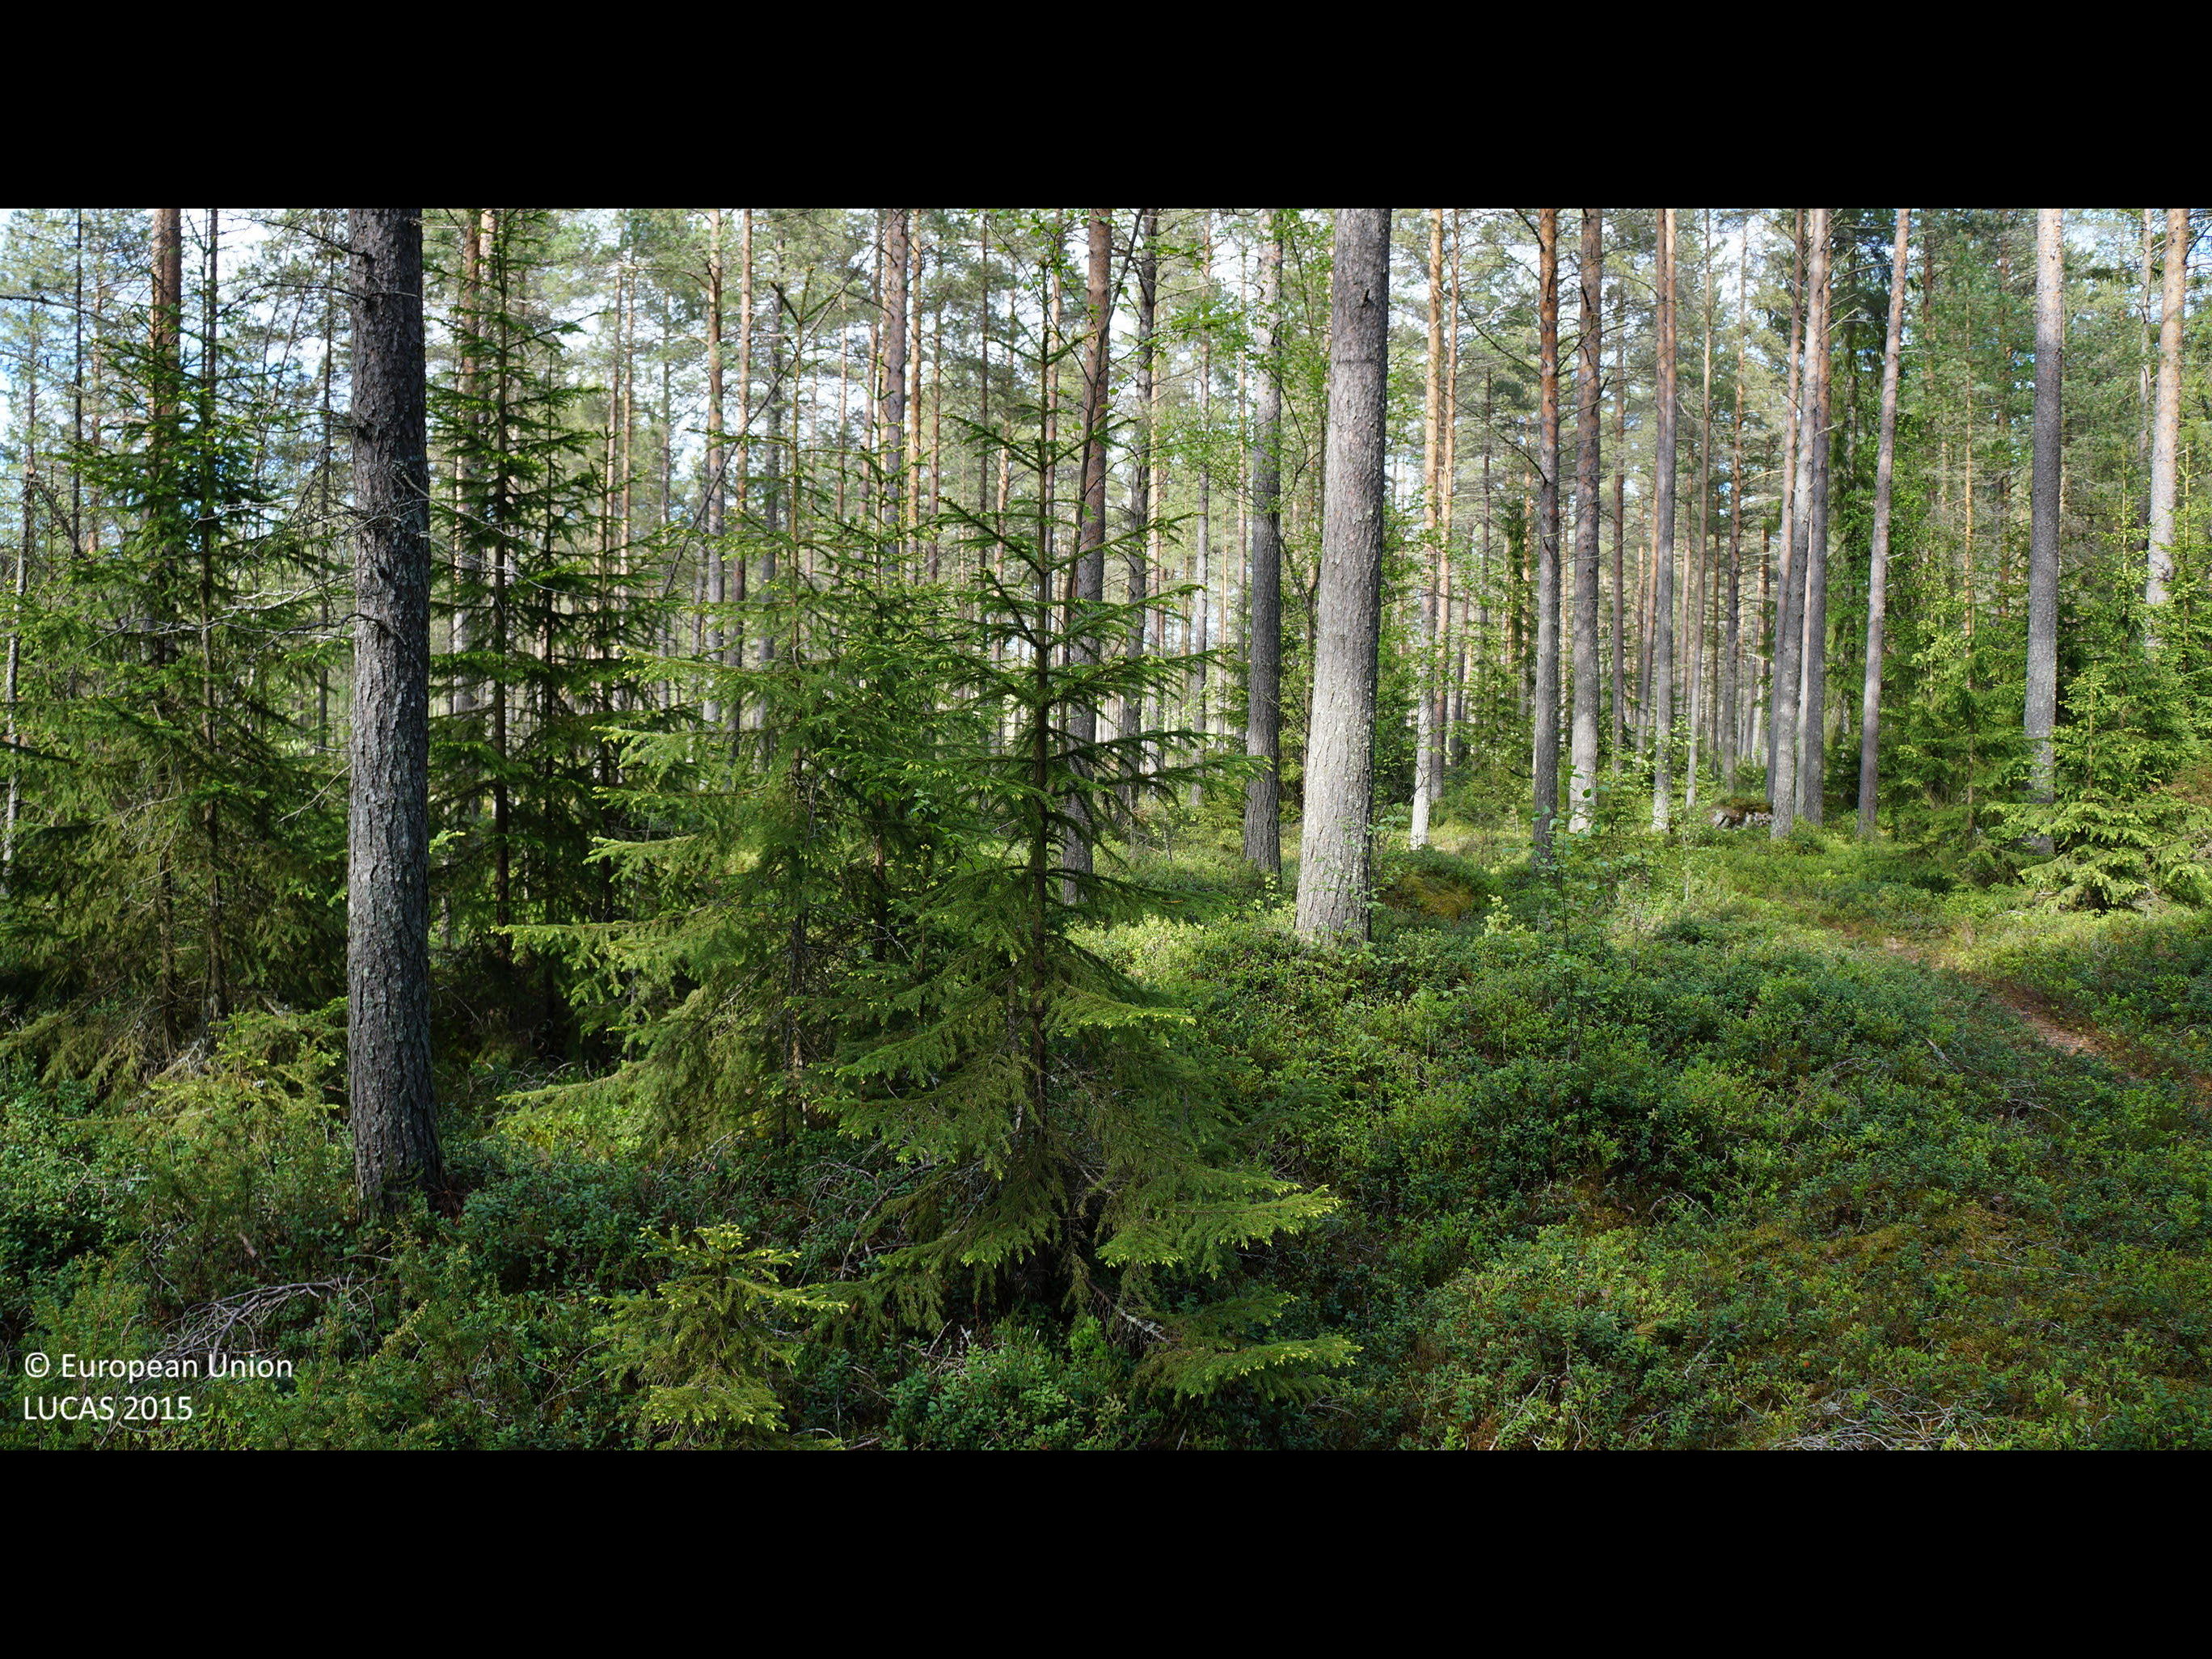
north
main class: Woodland
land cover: Pine dominated coniferous woodland
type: boreal forest
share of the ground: 50 - 75 %
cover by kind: coniferous forest trees 70 %, herbaceous plants 15 %, broadleaved forest trees 5 %, shrubs 5 %, lichens and mosses 5 %
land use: Forestry
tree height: > 5 m
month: June
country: FI
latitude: 64.2461
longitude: 23.8601
